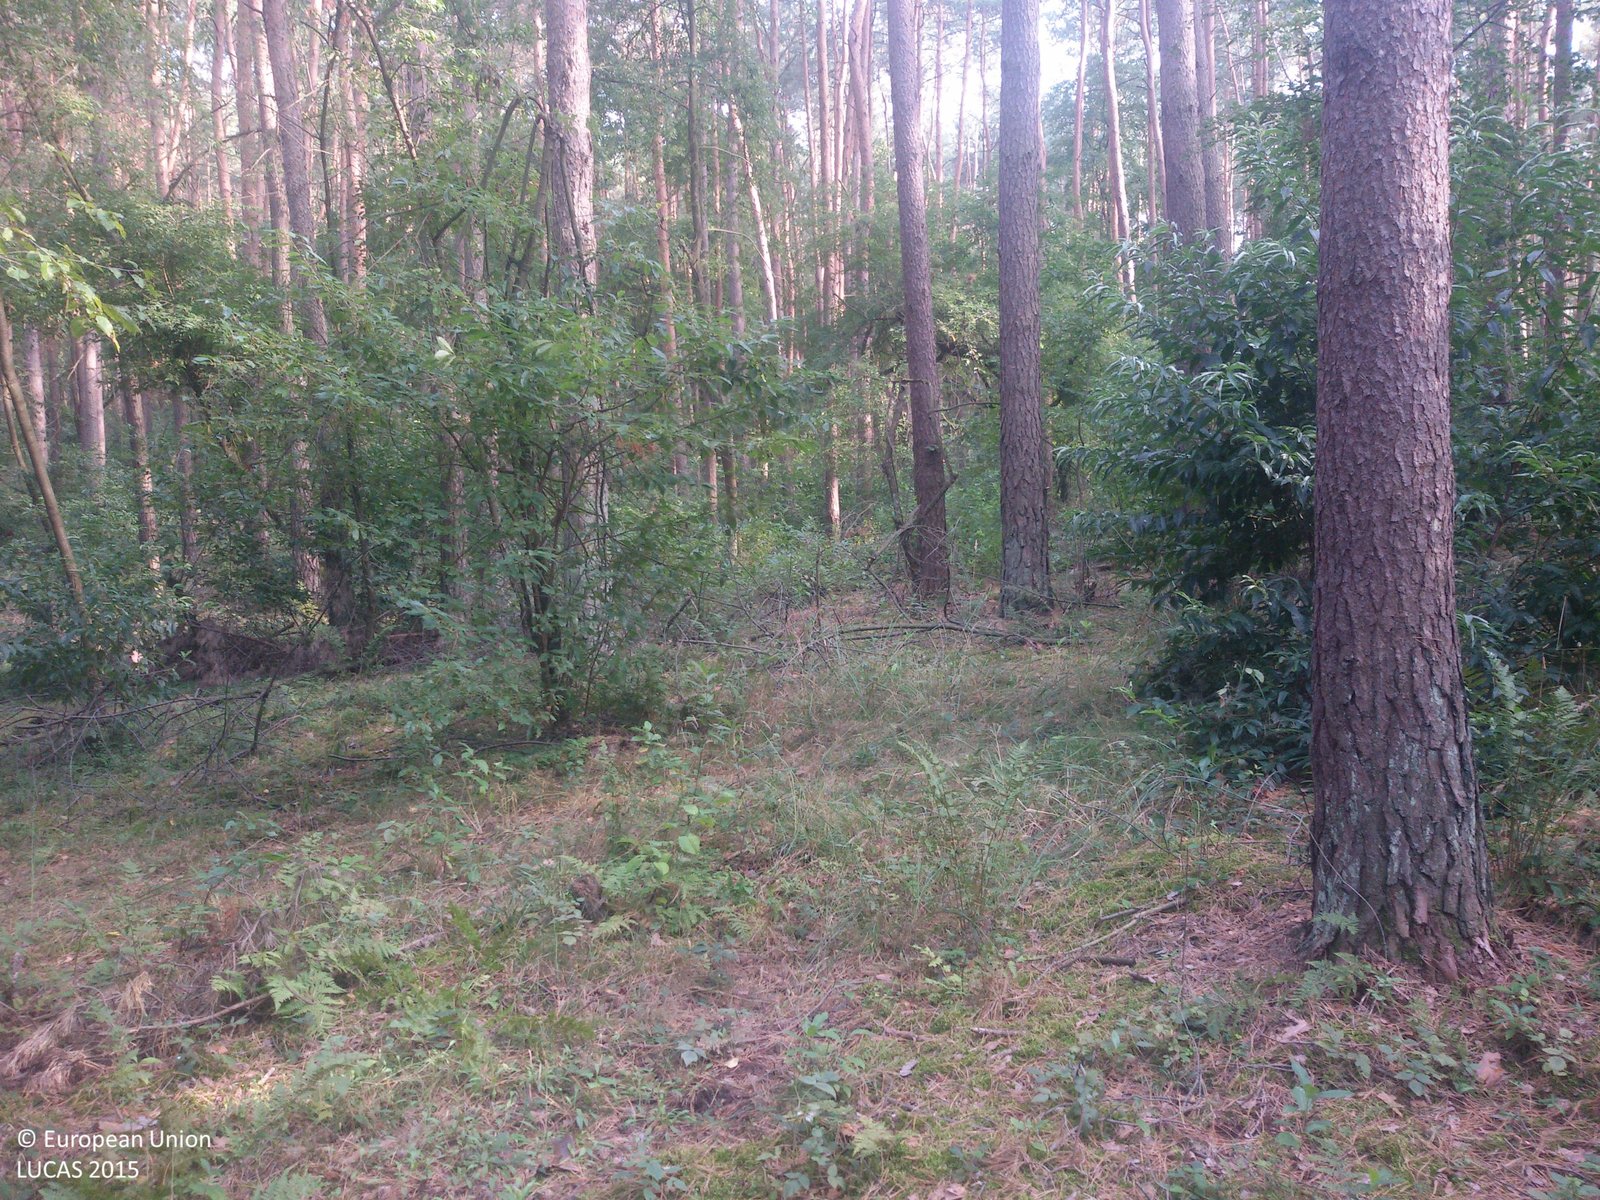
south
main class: Woodland
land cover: Pine dominated mixed woodland
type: hemiboreal forest and nemoral coniferous forest and mixed broadleaved-coniferous forest
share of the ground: > 75 %
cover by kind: coniferous forest trees 55 %, broadleaved forest trees 25 %, shrubs 10 %, herbaceous plants 5 %, unconsolidated bare surface 5 %
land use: Forestry
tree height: > 5 m
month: September
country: PL
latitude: 52.4502
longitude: 18.0054
